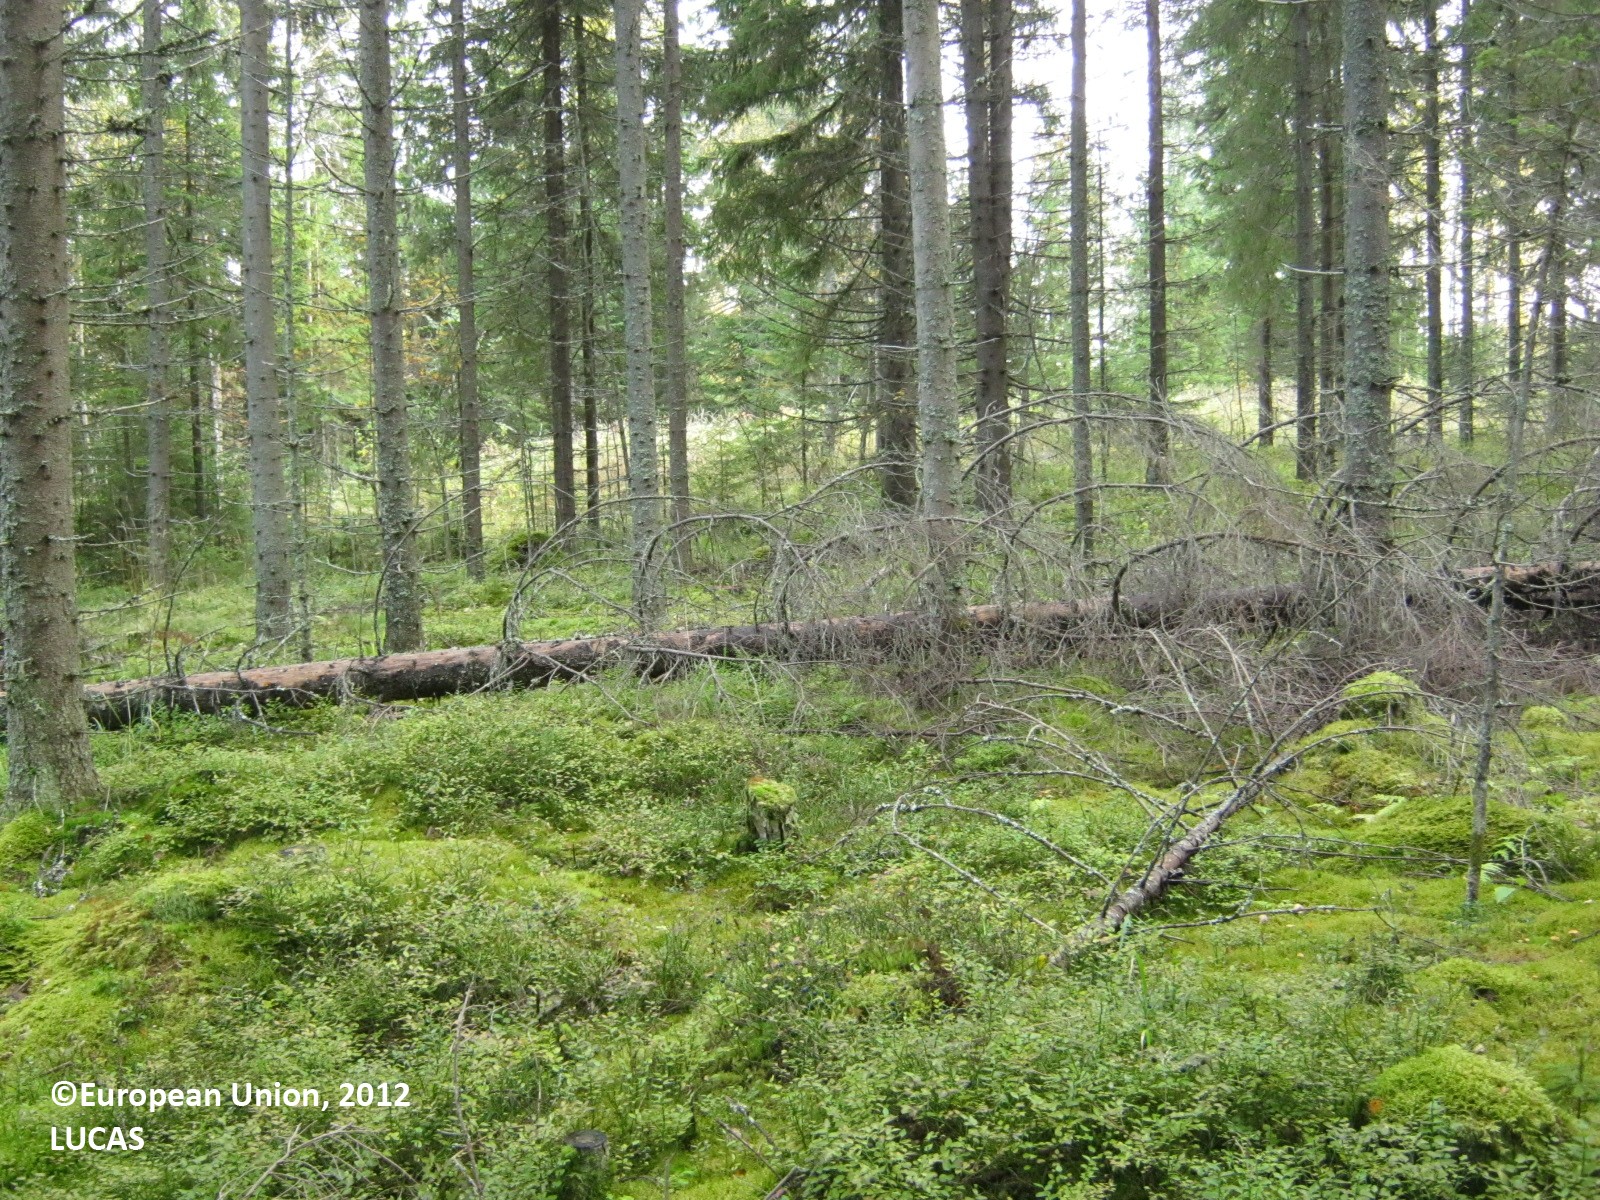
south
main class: Woodland
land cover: Spruce dominated coniferous woodland
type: boreal forest
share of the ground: 50 - 75 %
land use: Forestry
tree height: > 5 m
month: September
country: FI
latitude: 62.4050
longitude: 28.8905
